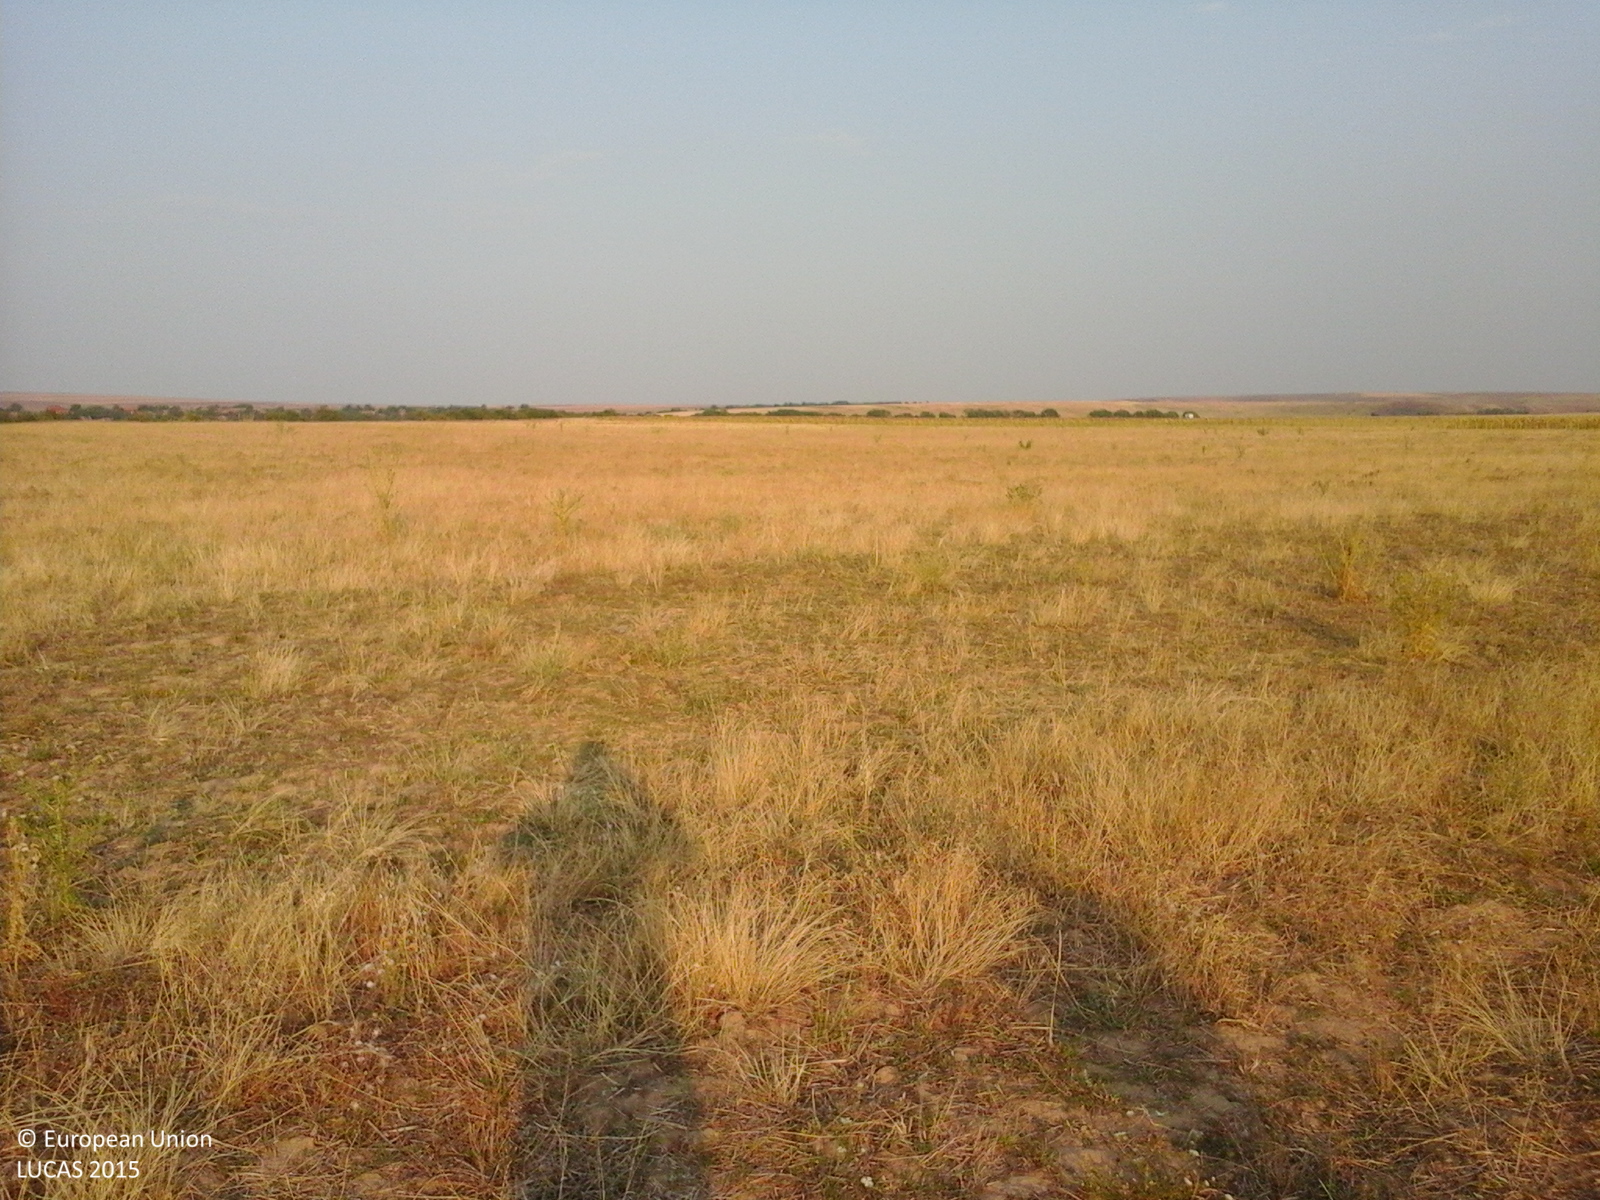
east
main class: Grassland
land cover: Spontaneously vegetated surfaces
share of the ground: > 75 %
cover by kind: herbaceous plants 100 %
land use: Fallow land
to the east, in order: Spontaneously vegetated surfaces; Other bare soil; Common wheat; Other bare soil
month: August
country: RO
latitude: 44.2819
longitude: 22.9620
